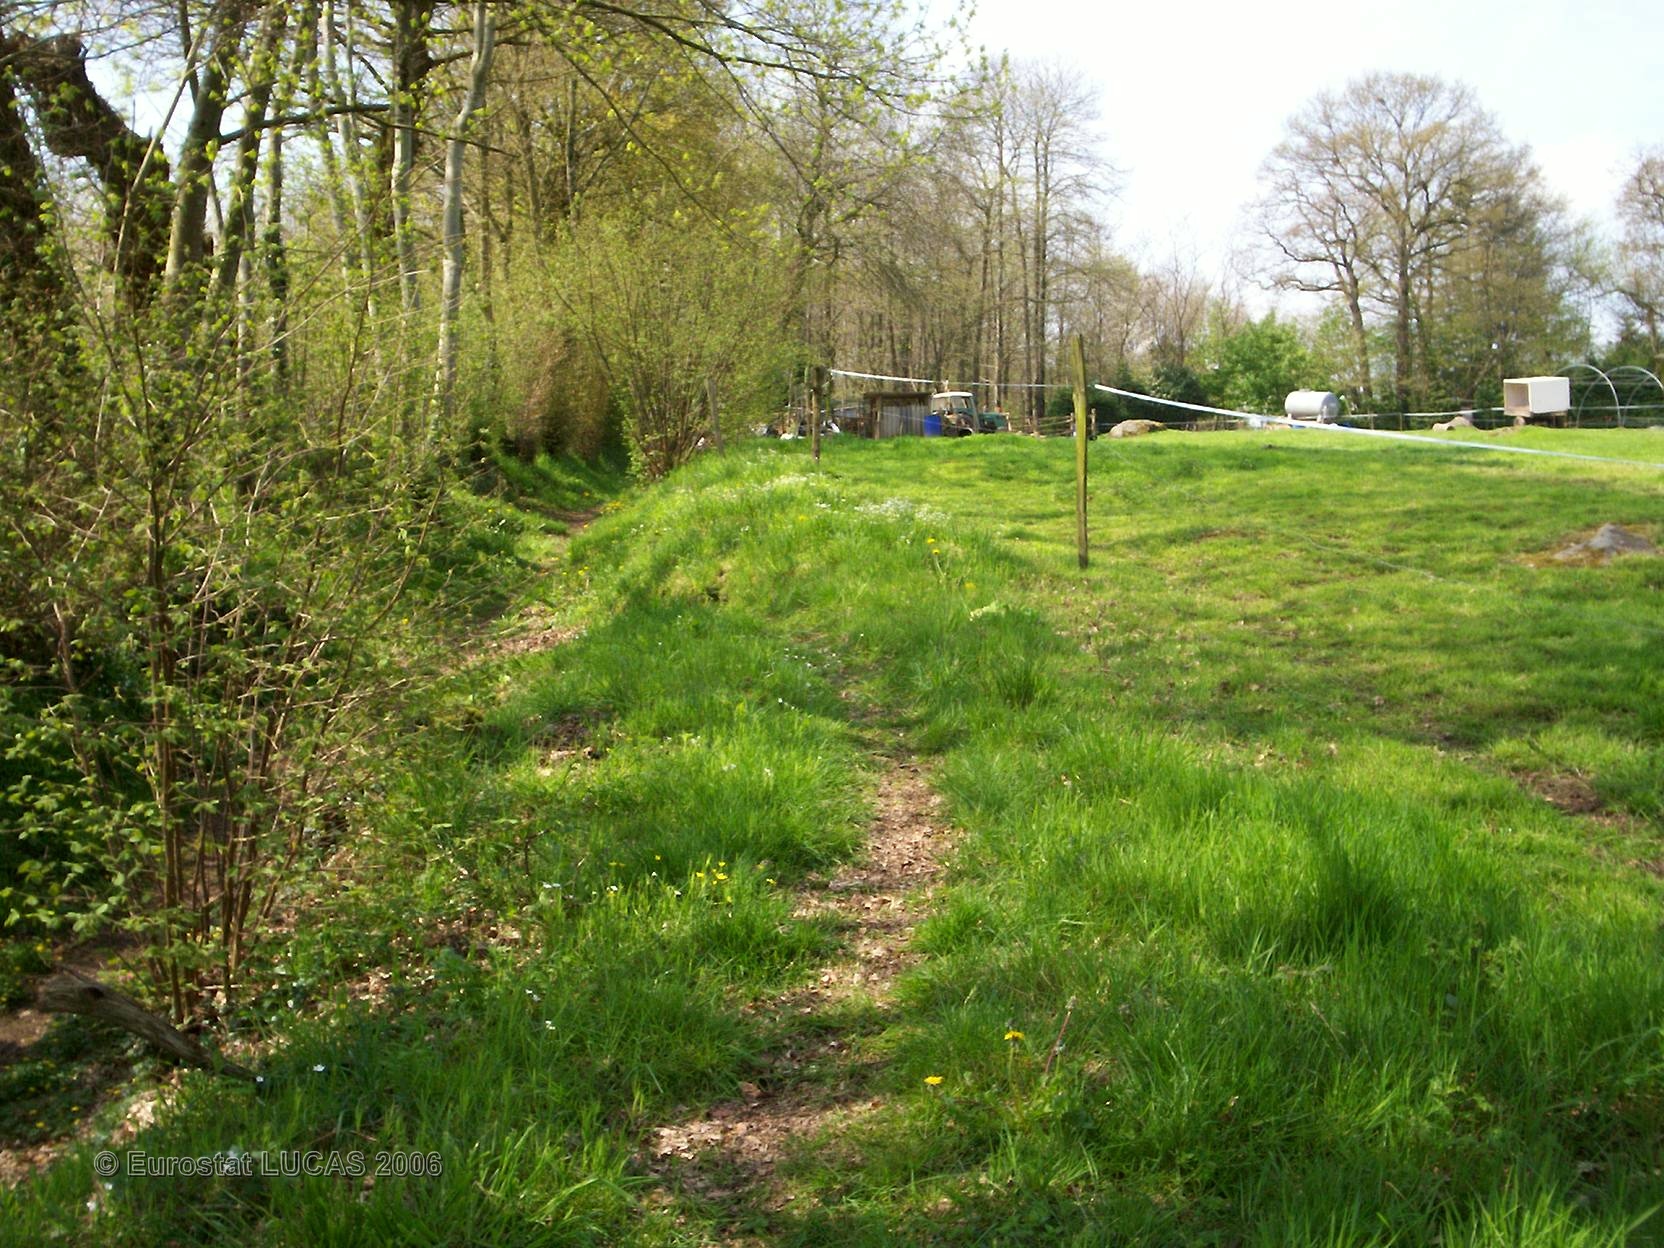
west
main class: Grassland
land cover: Grassland without tree/shrub cover
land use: Agriculture (excluding fallow land and kitchen gardens)
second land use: Sport
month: May
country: FR
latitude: 48.2768
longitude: -2.4705
